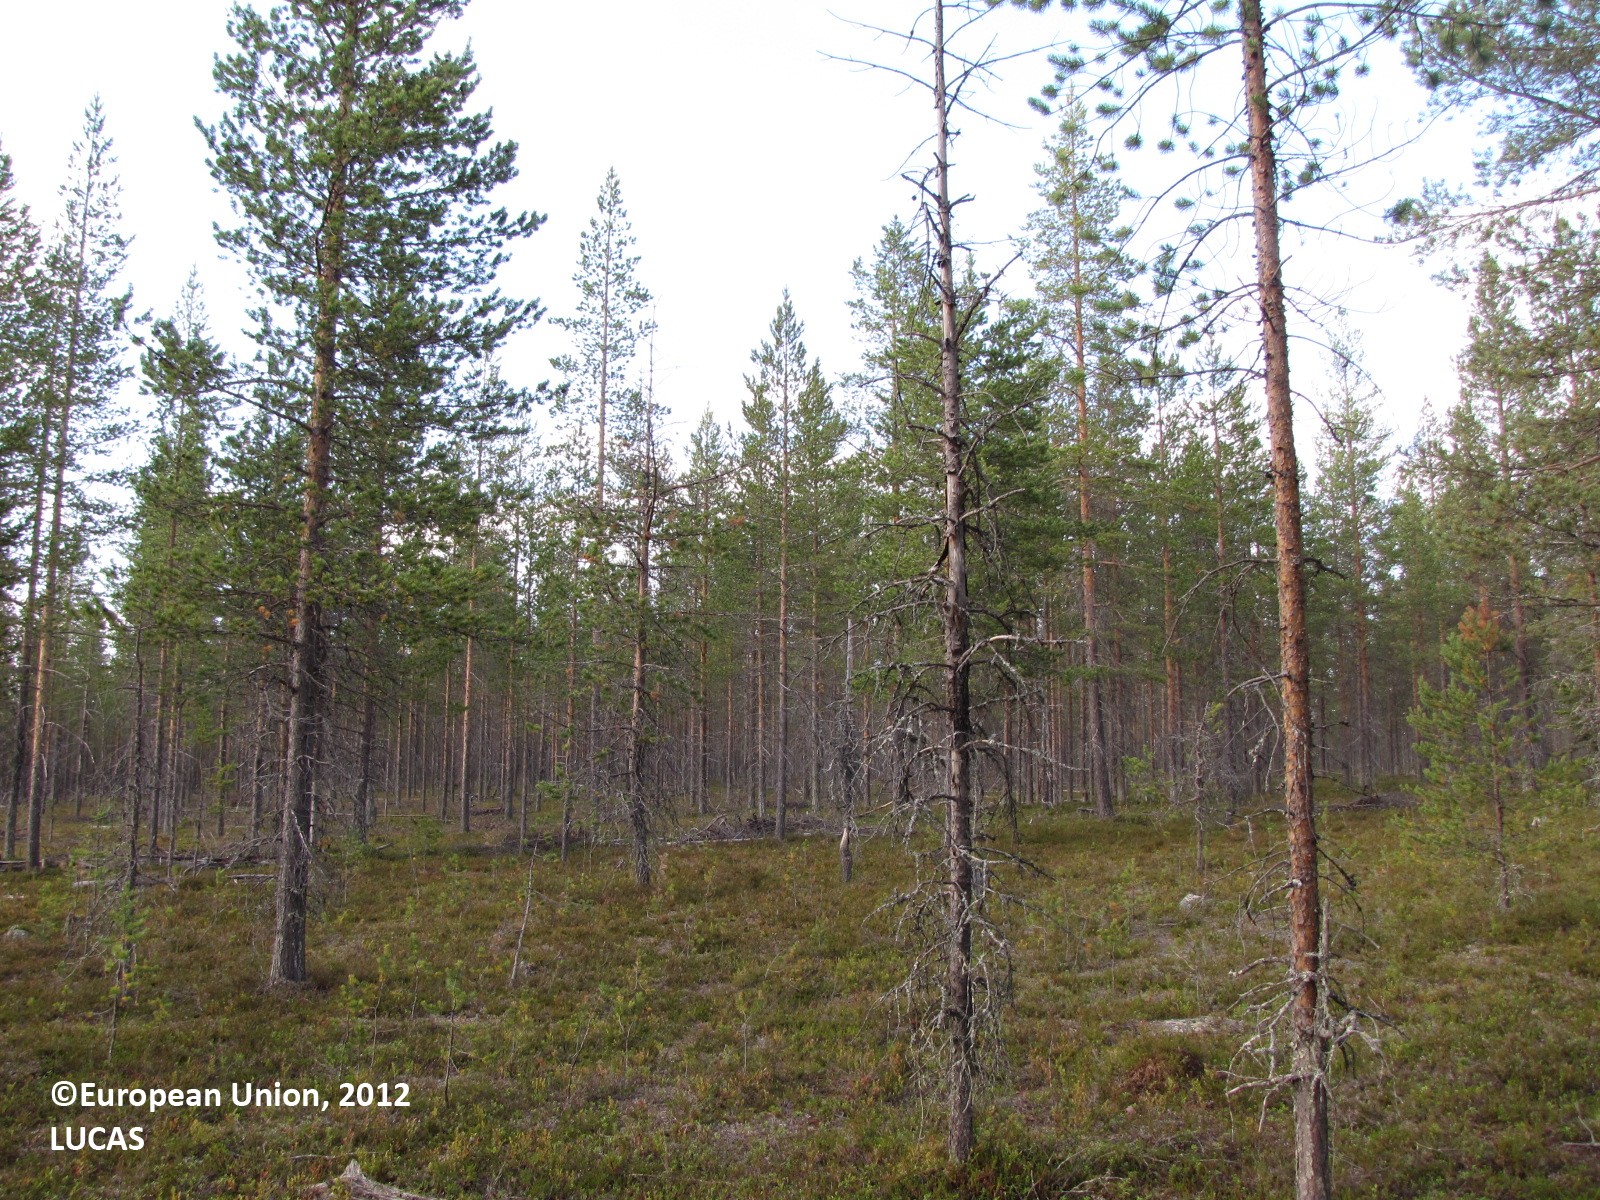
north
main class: Woodland
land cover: Pine dominated coniferous woodland
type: boreal forest
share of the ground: 25 - 50 %
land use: Forestry
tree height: > 5 m
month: August
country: FI
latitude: 67.0228
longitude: 25.0375
